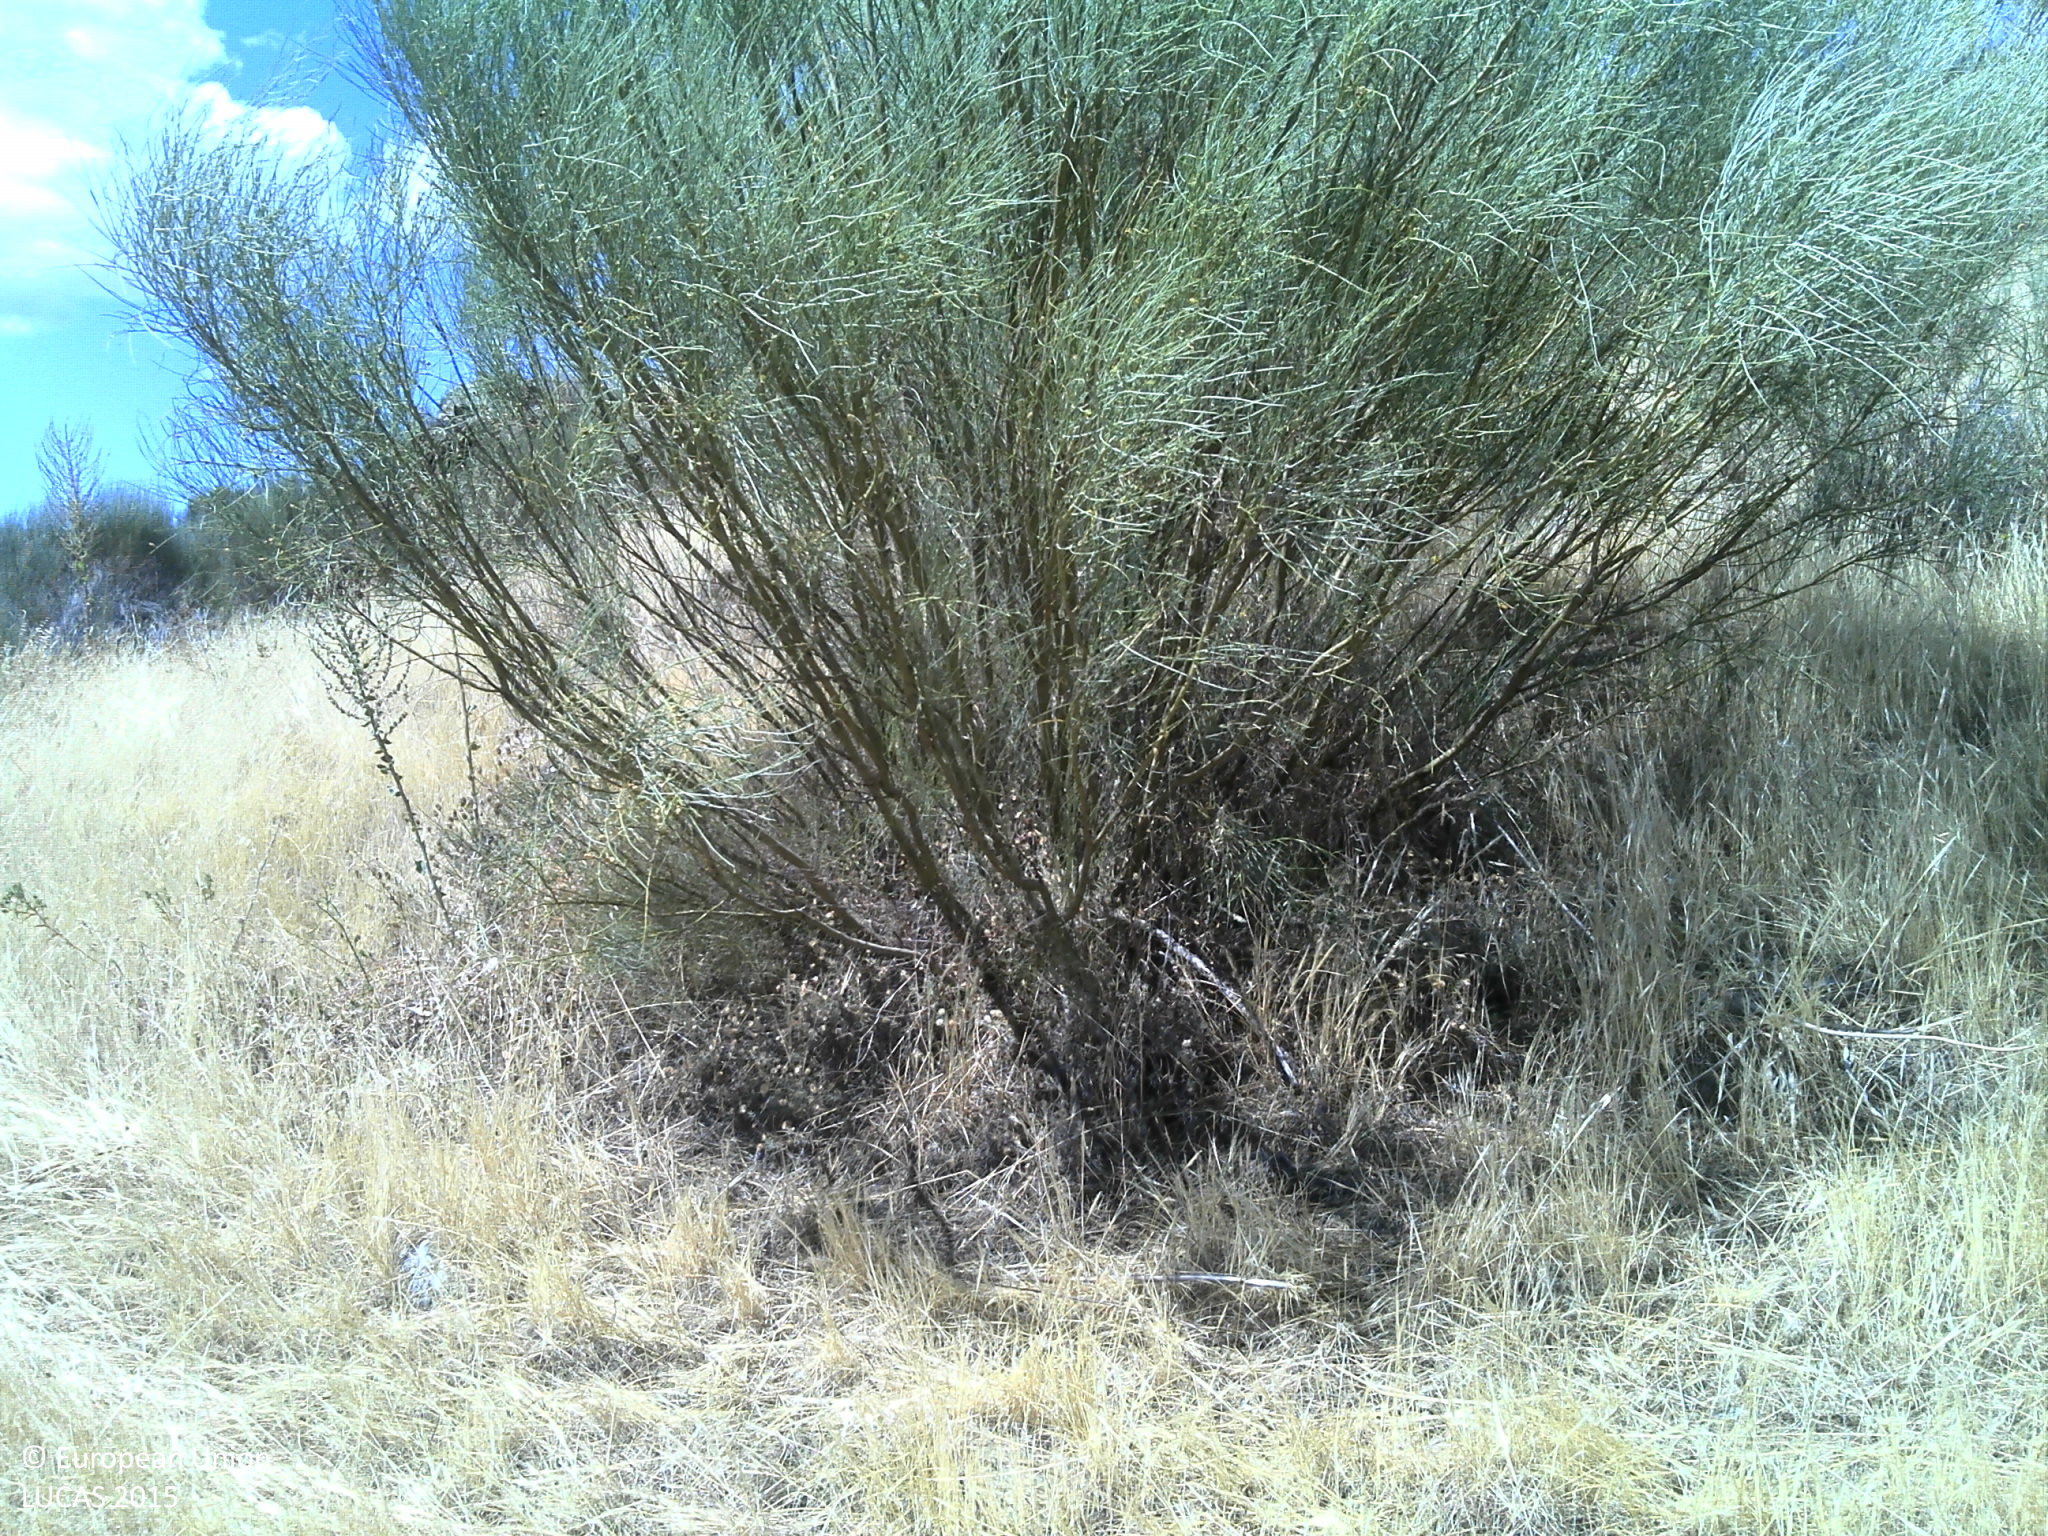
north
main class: Shrubland
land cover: Shrubland without tree cover
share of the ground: 25 - 50 %
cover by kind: herbaceous plants 55 %, shrubs 30 %, unconsolidated bare surface 10 %, consolidated bare surface 5 %
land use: Abandoned areas
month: July
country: PT
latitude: 41.3301
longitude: -7.0193
